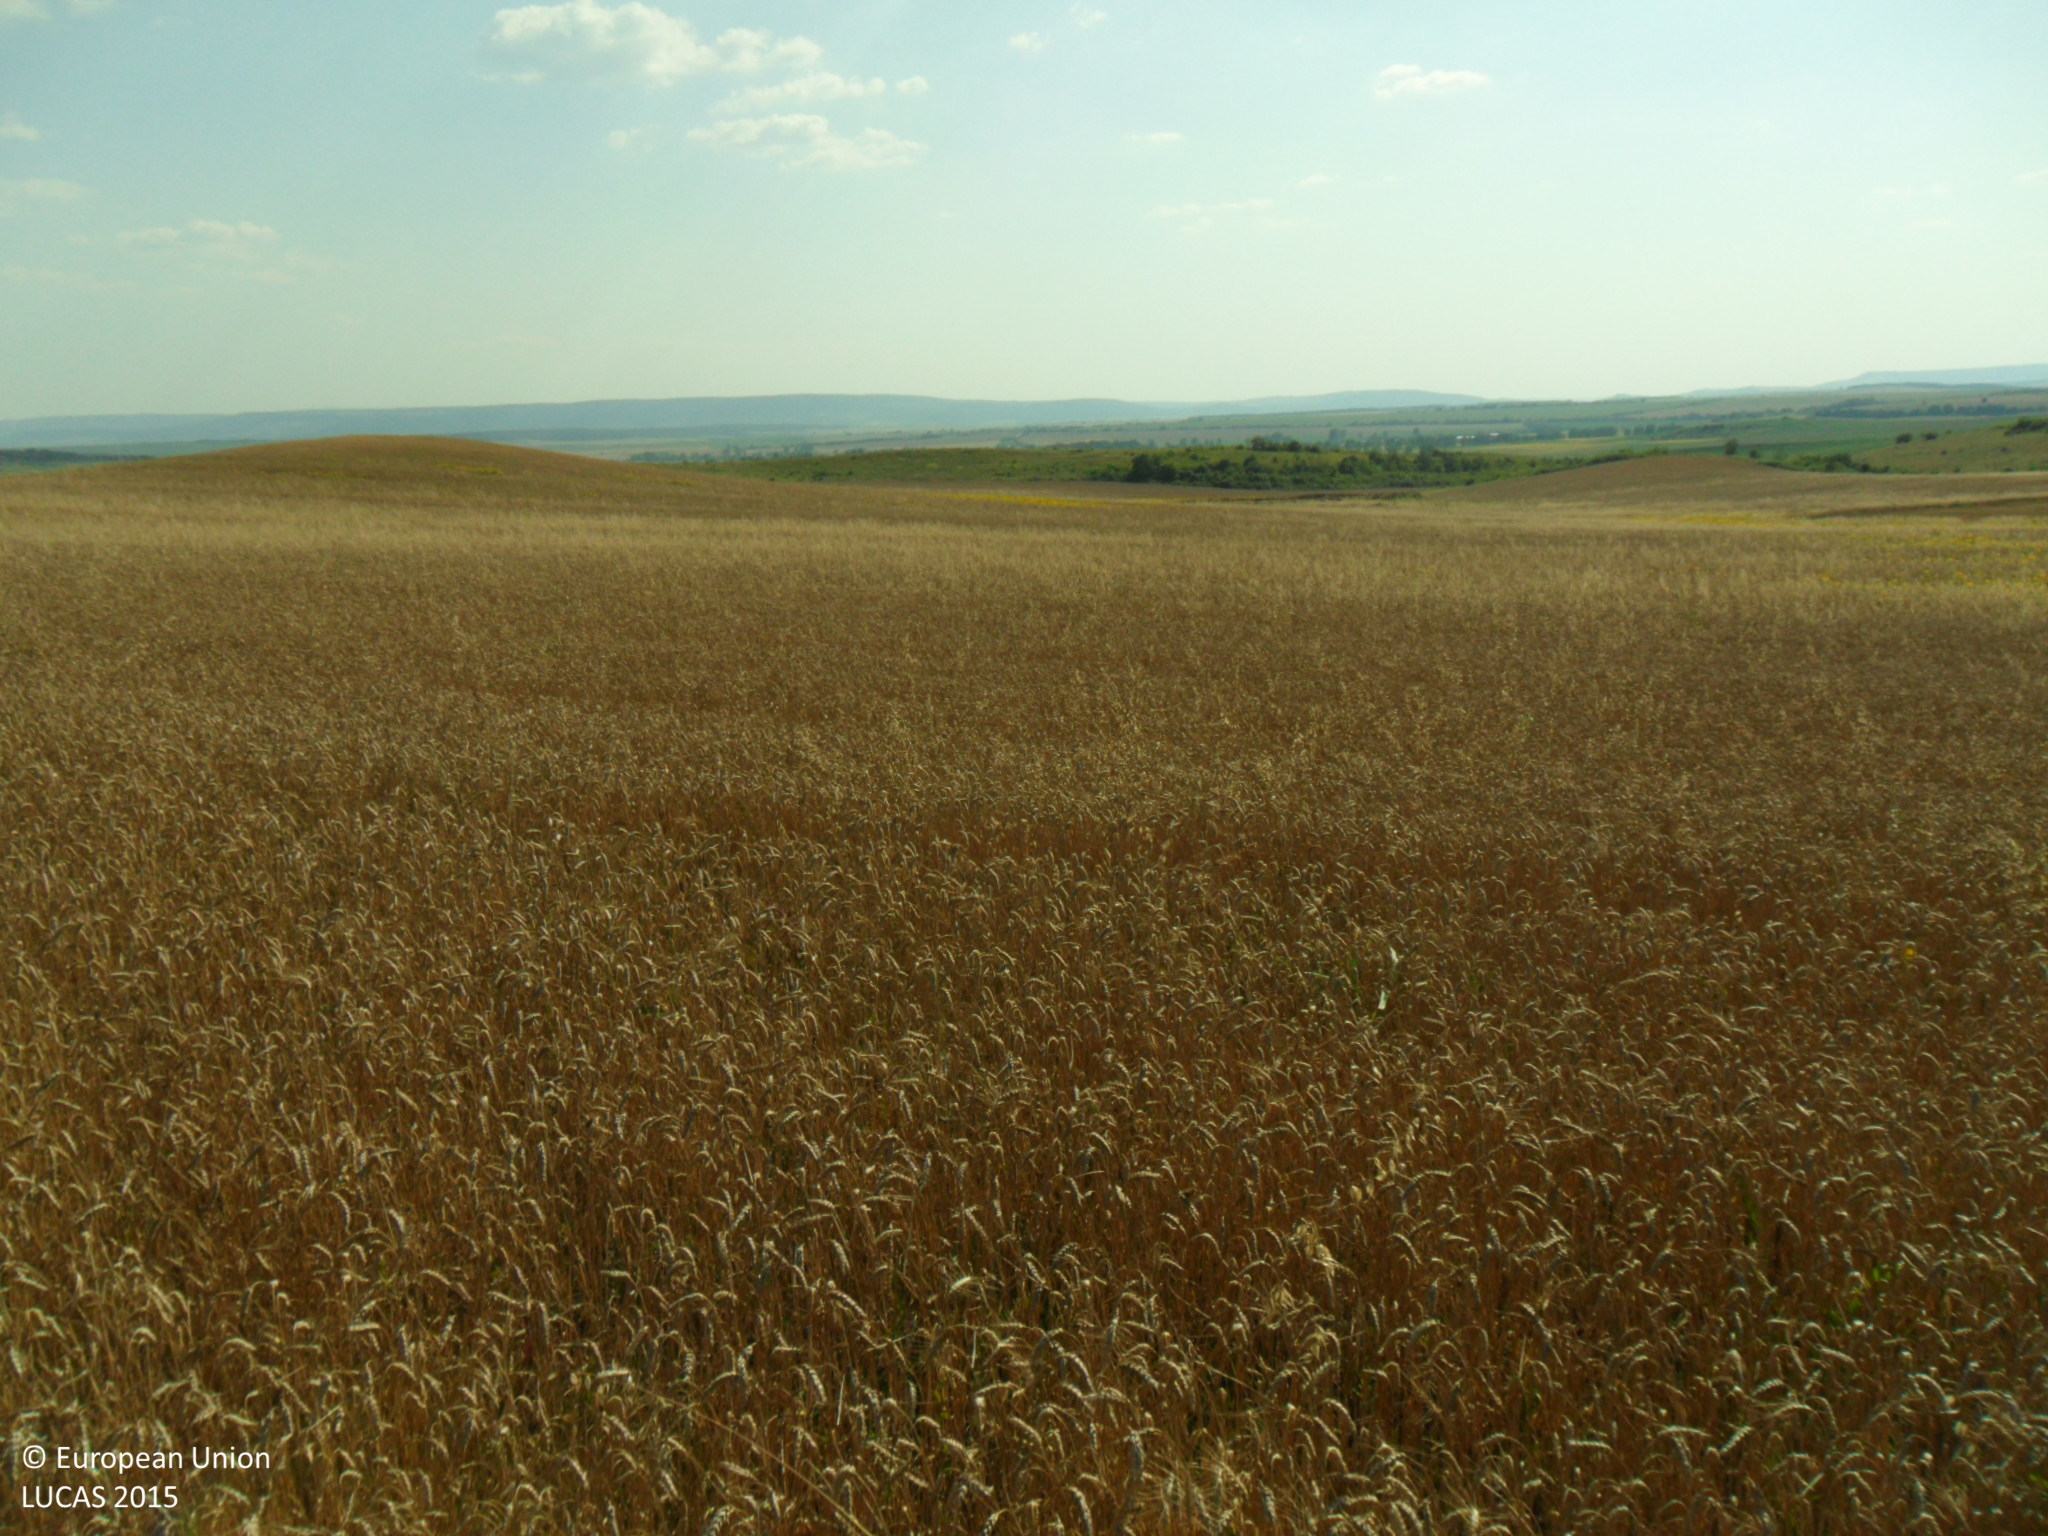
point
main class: Cropland
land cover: Common wheat
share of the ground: > 75 %
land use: Agriculture (excluding fallow land and kitchen gardens)
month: July
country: BG
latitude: 43.3945
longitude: 26.5621
